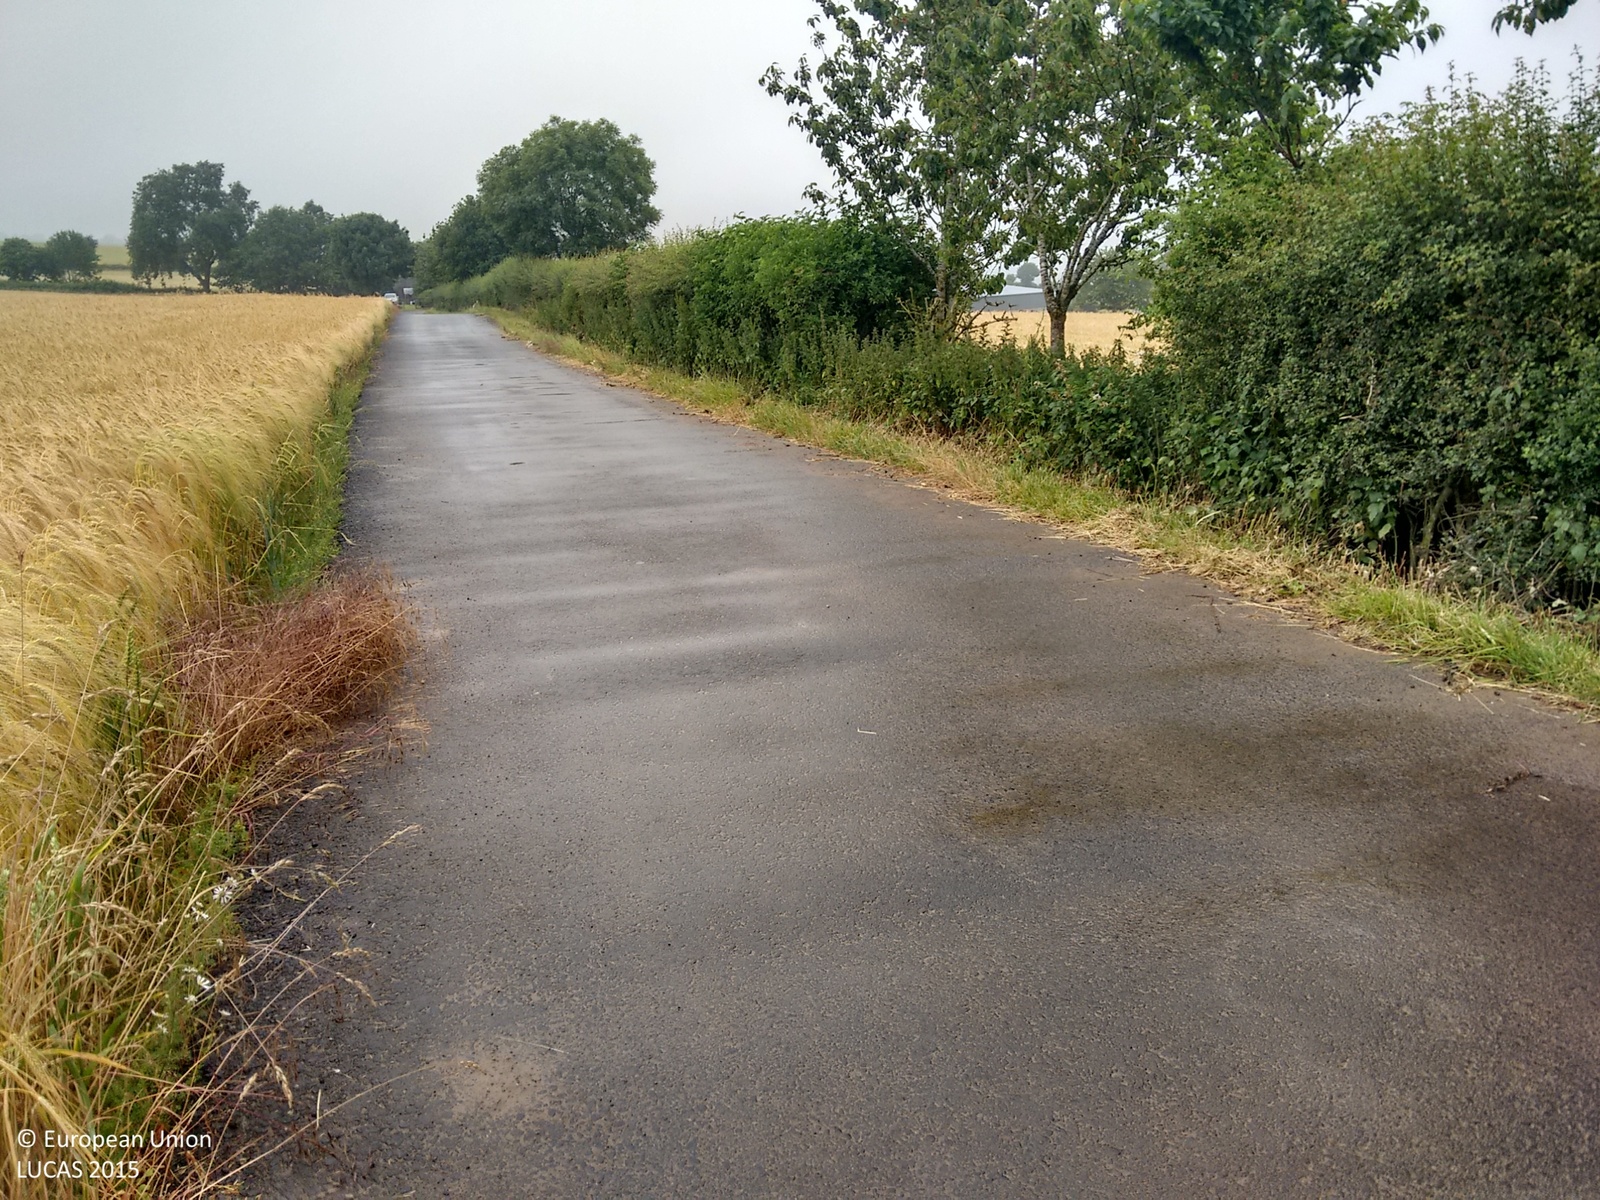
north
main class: Cropland
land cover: Barley
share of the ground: > 75 %
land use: Agriculture (excluding fallow land and kitchen gardens)
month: July
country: GB
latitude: 52.3691
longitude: -2.8352
